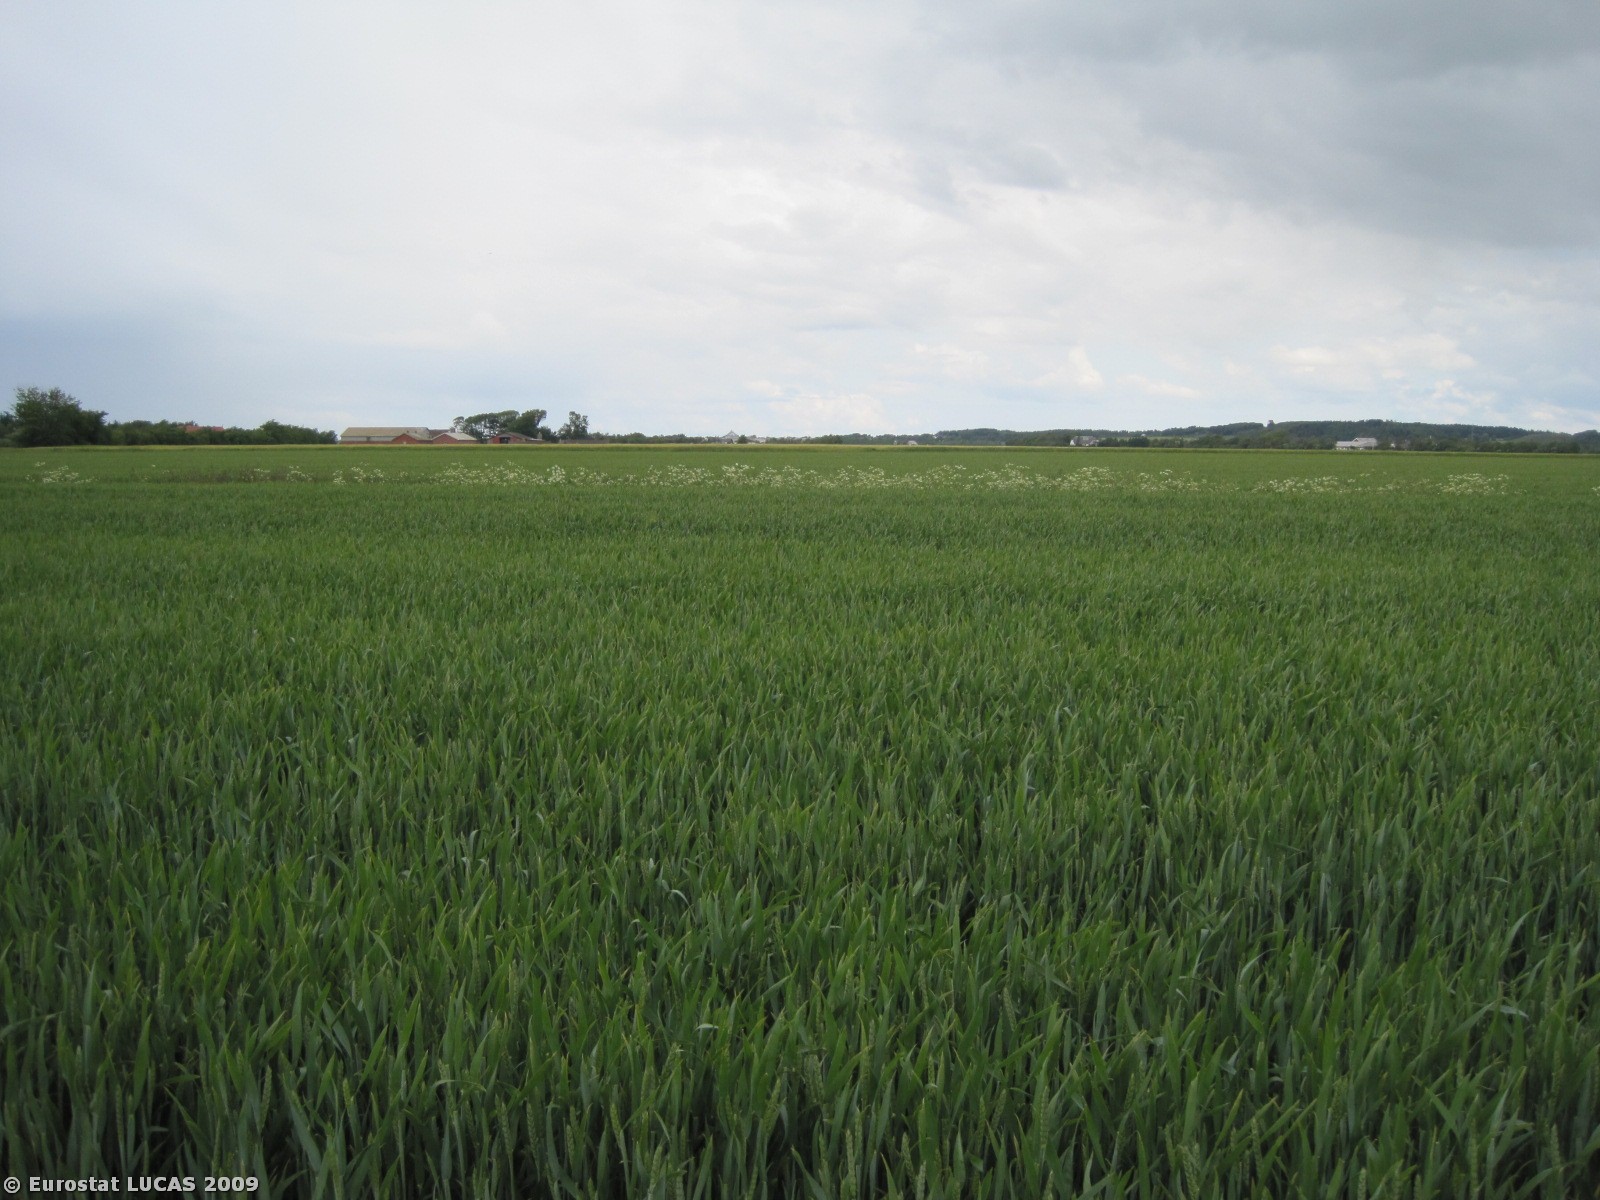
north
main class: Cropland
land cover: Common wheat
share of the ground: > 75 %
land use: Agriculture (excluding fallow land and kitchen gardens)
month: June
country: DK
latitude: 57.2662
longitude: 9.7848
